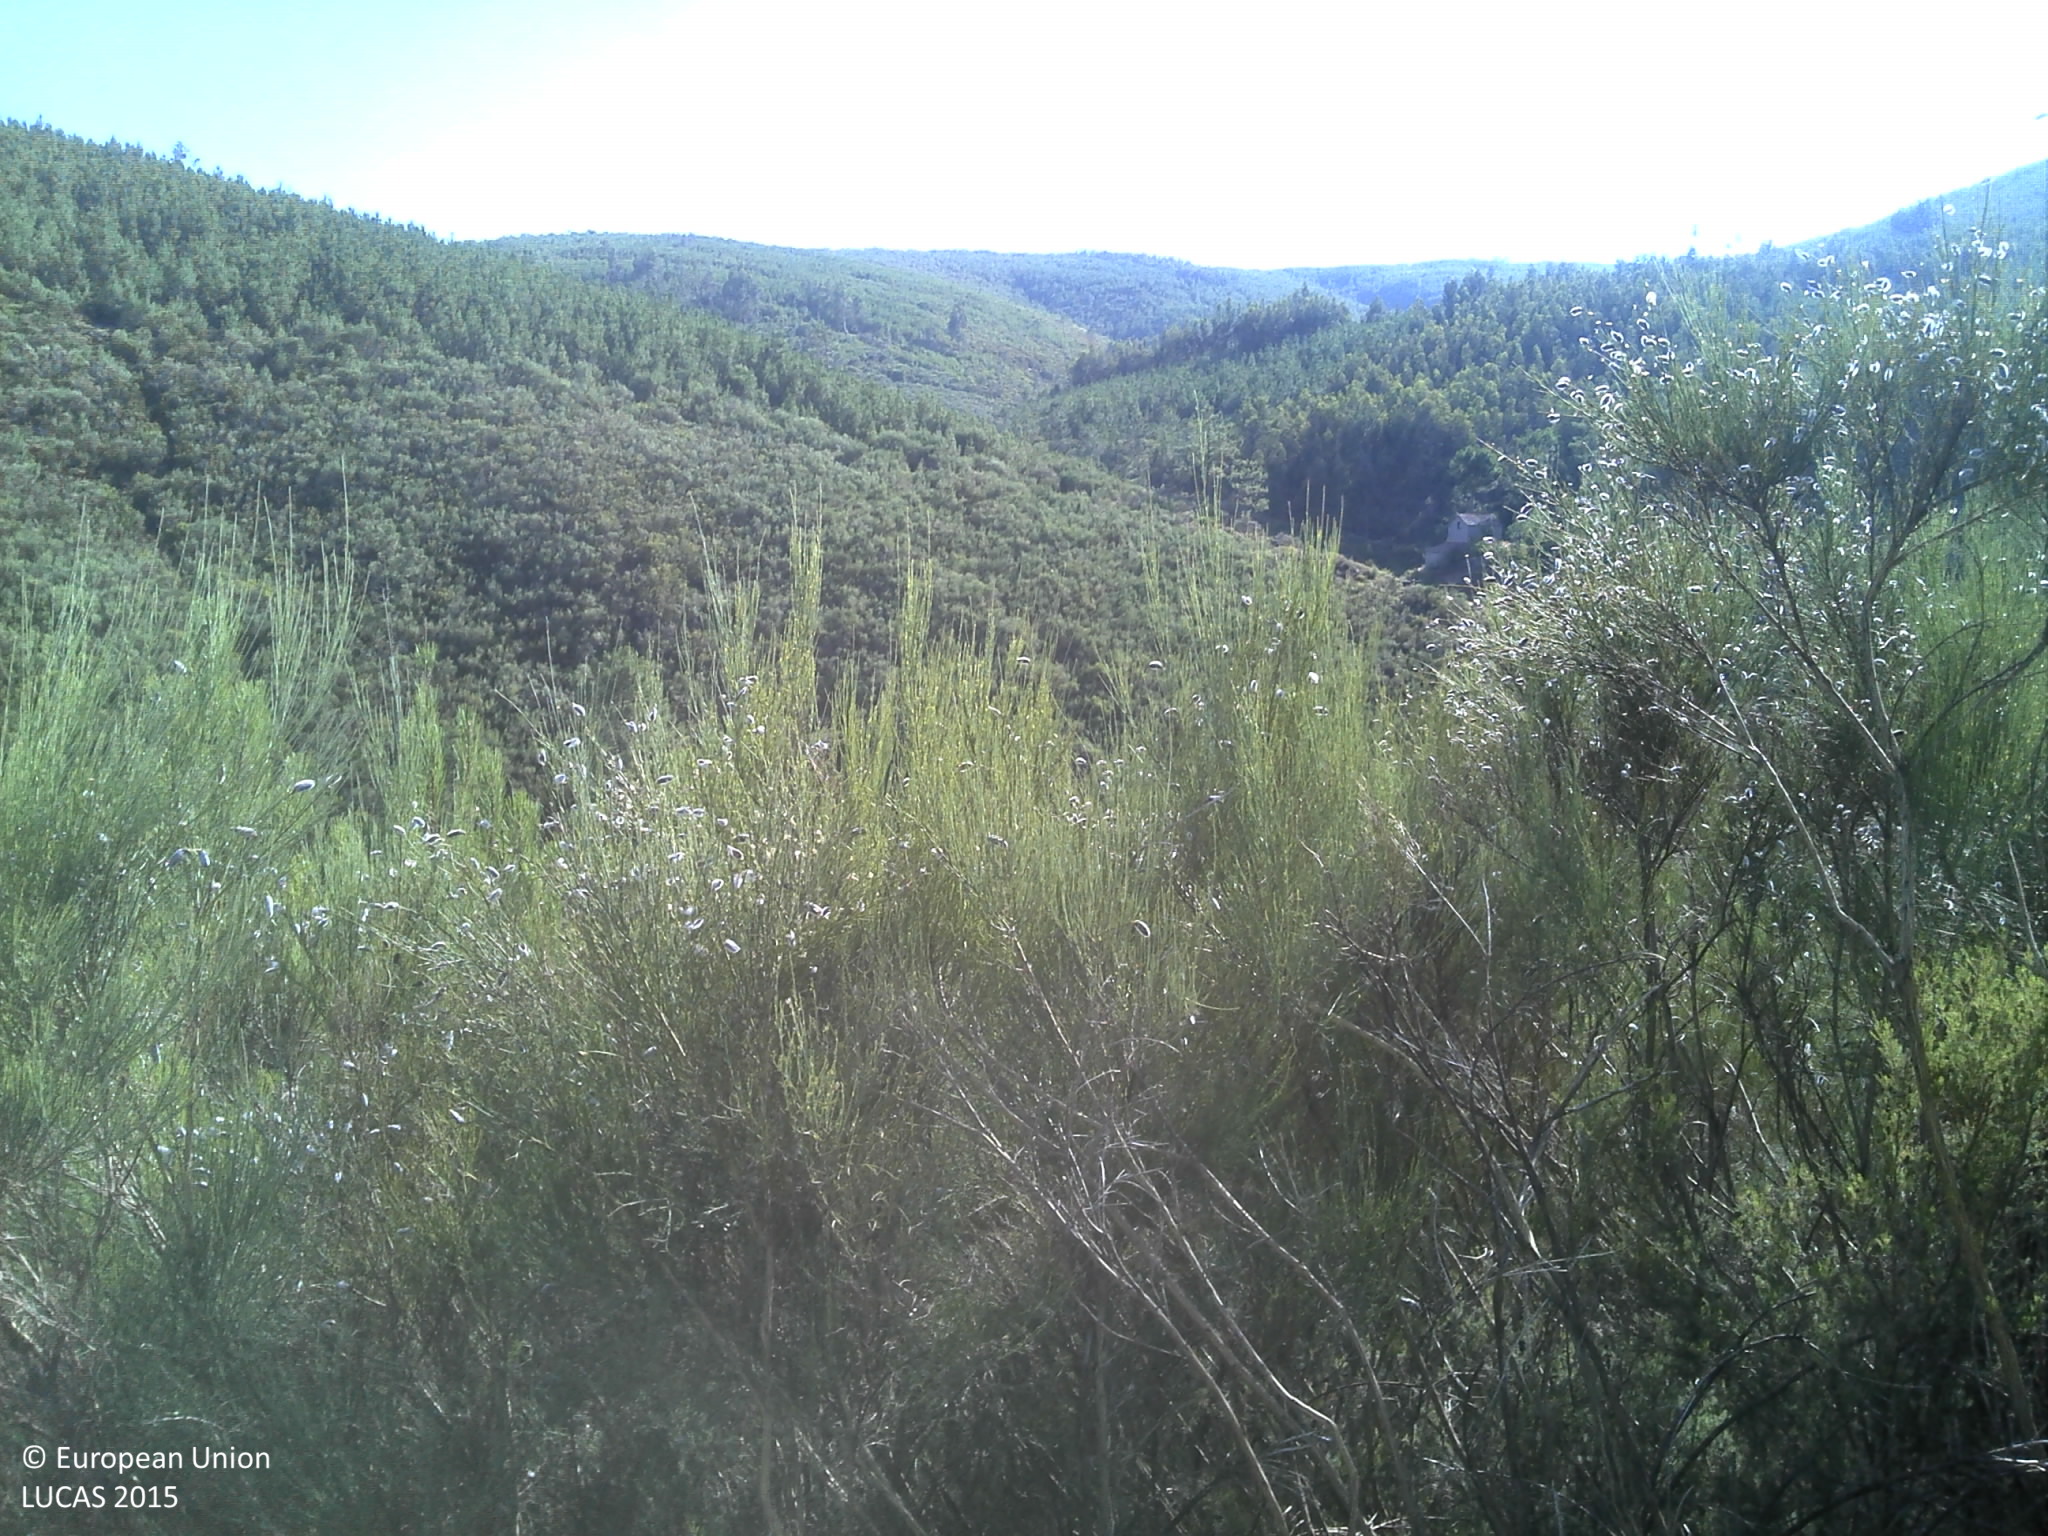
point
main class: Shrubland
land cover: Shrubland without tree cover
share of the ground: > 75 %
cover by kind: shrubs 90 %, unconsolidated bare surface 5 %
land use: Abandoned areas
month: July
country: PT
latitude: 40.1309
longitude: -7.8460
